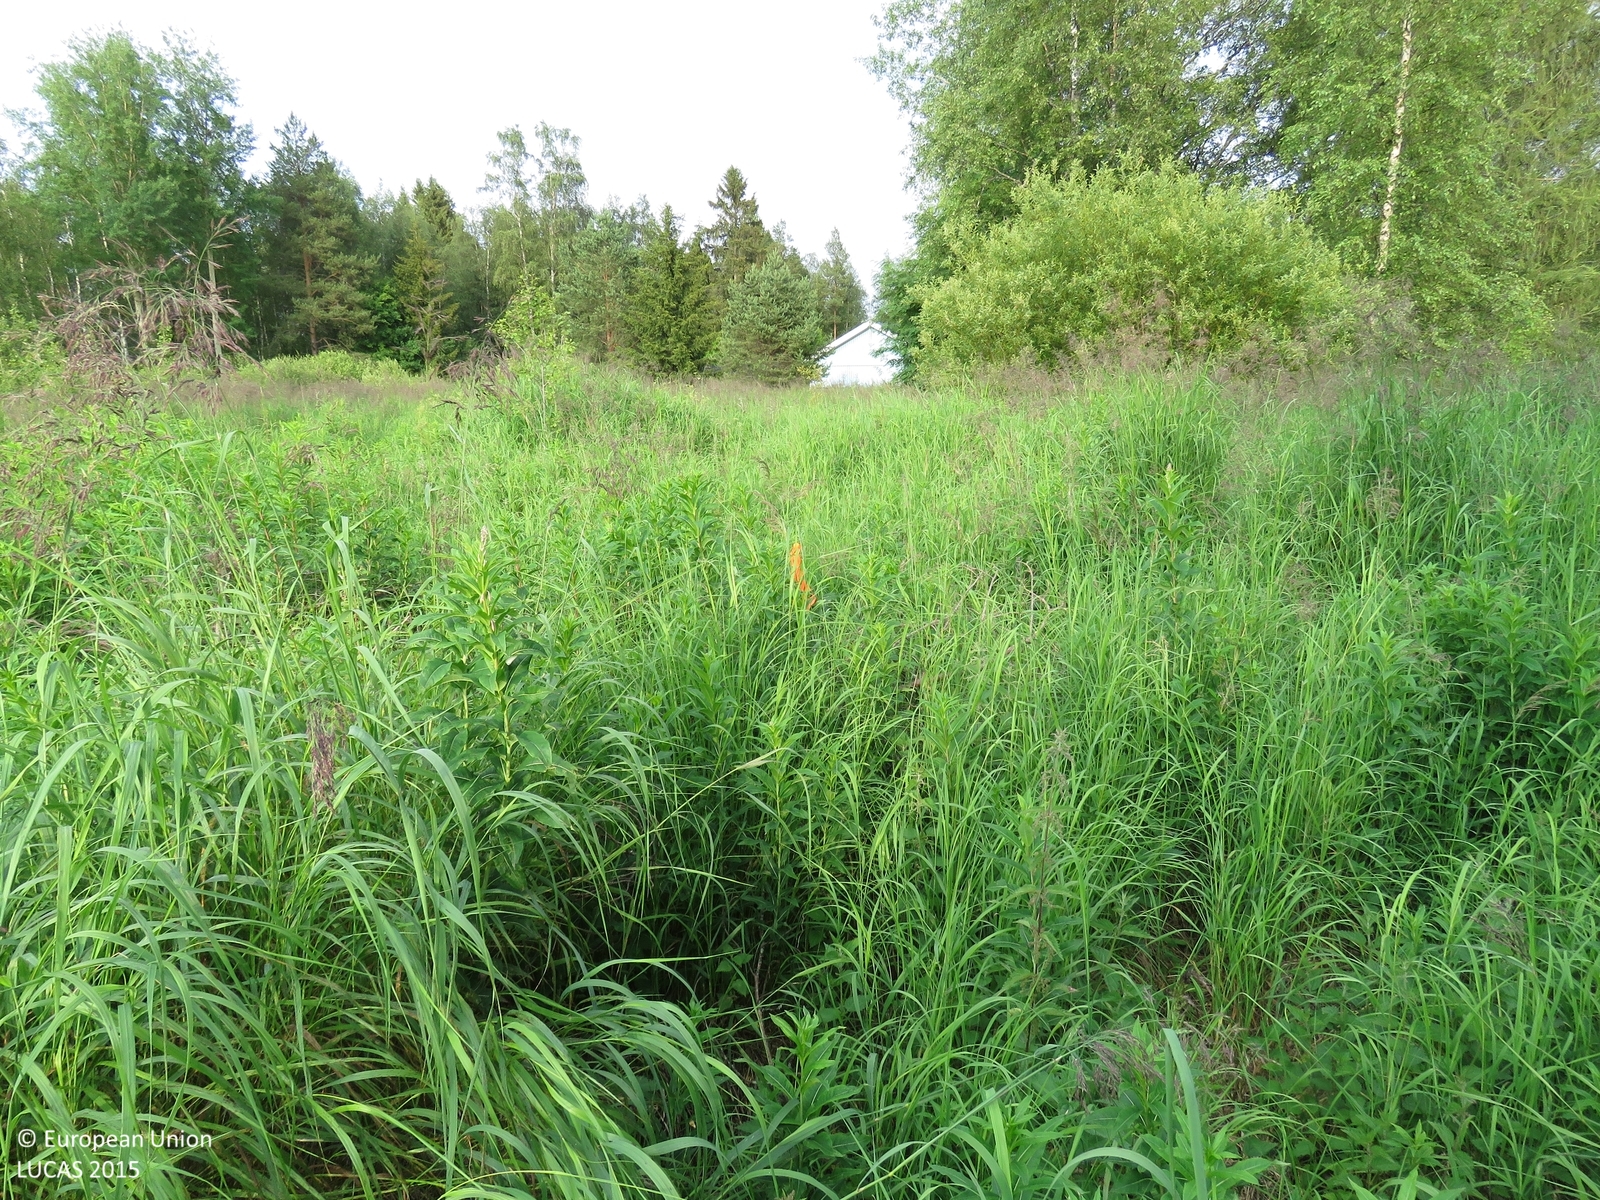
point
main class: Grassland
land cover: Grassland with sparse tree/shrub cover
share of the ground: > 75 %
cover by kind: herbaceous plants 90 %, broadleaved forest trees 5 %, shrubs 5 %
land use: Abandoned areas
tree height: < 5 m
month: July
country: FI
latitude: 64.7975
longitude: 26.0318
